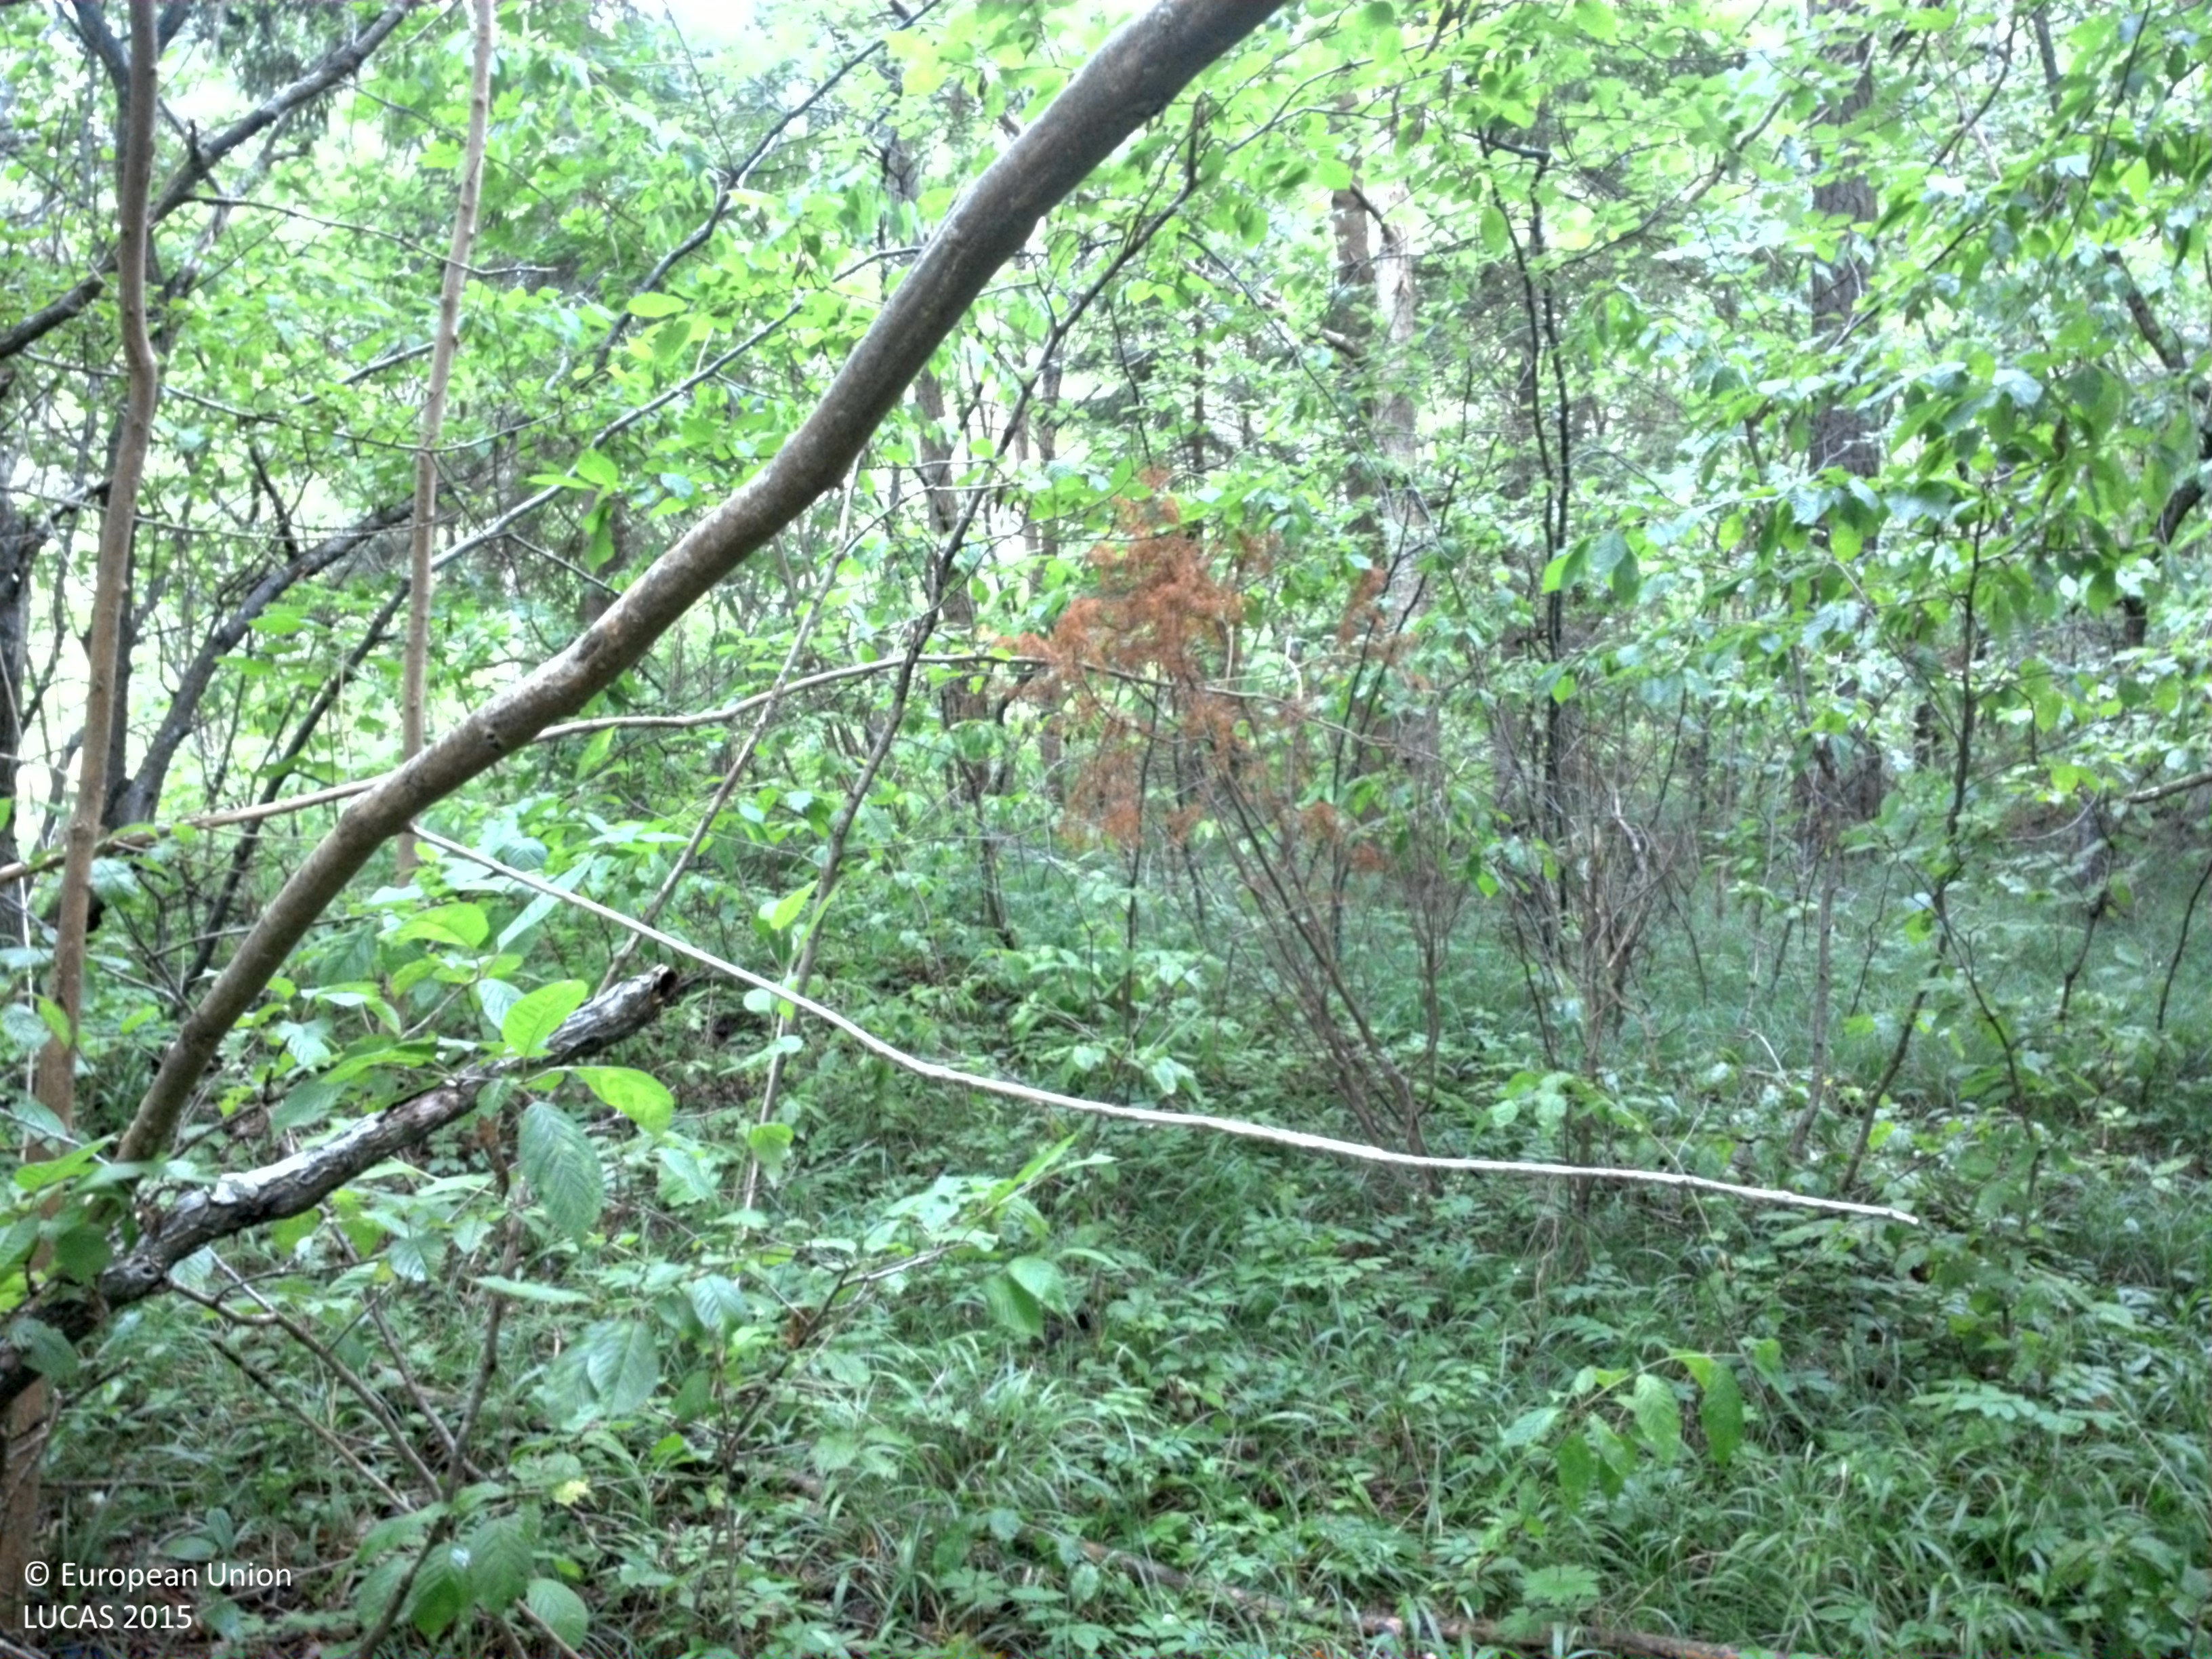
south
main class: Woodland
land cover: Pine dominated mixed woodland
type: hemiboreal forest and nemoral coniferous forest and mixed broadleaved-coniferous forest
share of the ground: > 75 %
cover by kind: coniferous forest trees 45 %, broadleaved forest trees 35 %, herbaceous plants 15 %, shrubs 5 %
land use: Forestry
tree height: > 5 m
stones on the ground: < 10 %
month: July
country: SE
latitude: 57.6035
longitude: 18.2569
